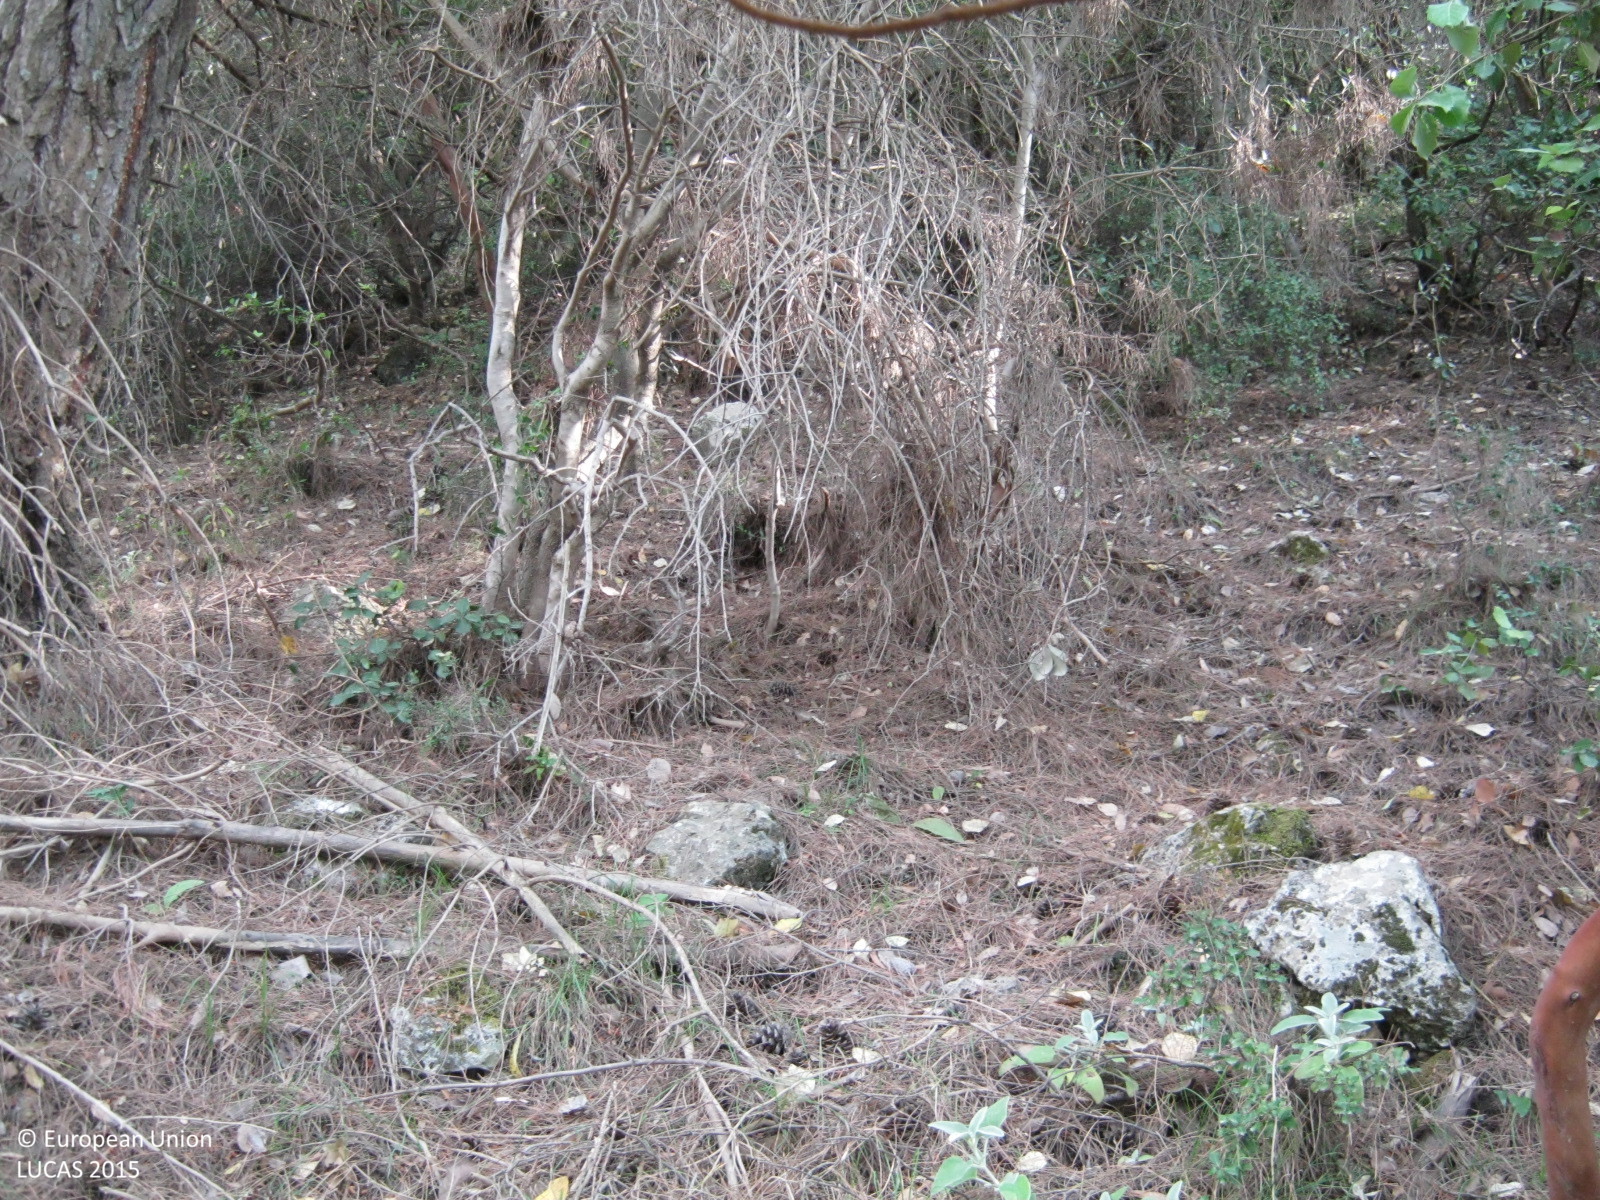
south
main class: Woodland
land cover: Other mixed woodland
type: coniferous forest of the mediterranean region
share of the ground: > 75 %
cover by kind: coniferous forest trees 55 %, broadleaved forest trees 25 %, shrubs 10 %, herbaceous plants 5 %, unconsolidated bare surface 5 %
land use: Semi-natural and natural areas not in use
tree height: > 5 m
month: June
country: GR
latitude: 35.3469
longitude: 23.7461
